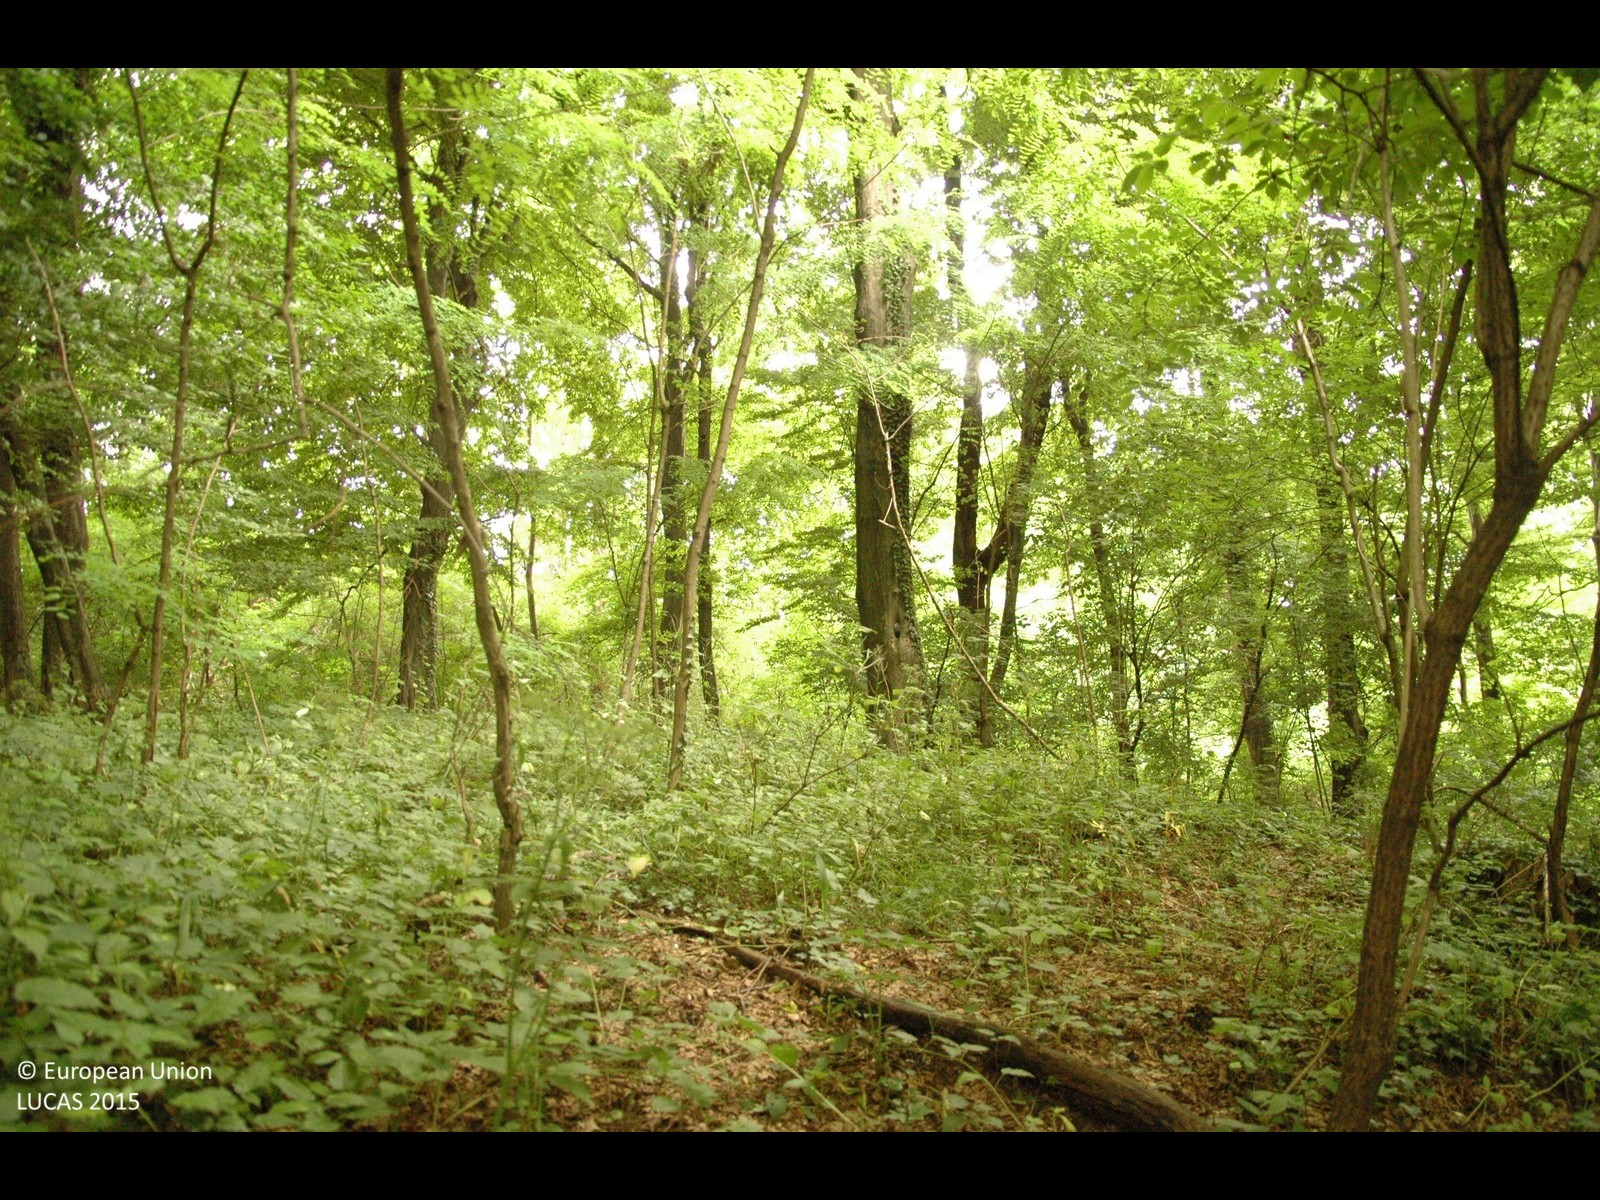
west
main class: Woodland
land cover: Broadleaved woodland
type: mesophytic deciduous forest
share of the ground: > 75 %
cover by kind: broadleaved forest trees 100 %
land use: Forestry
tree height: > 5 m
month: June
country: HR
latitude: 46.4505
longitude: 16.3666
